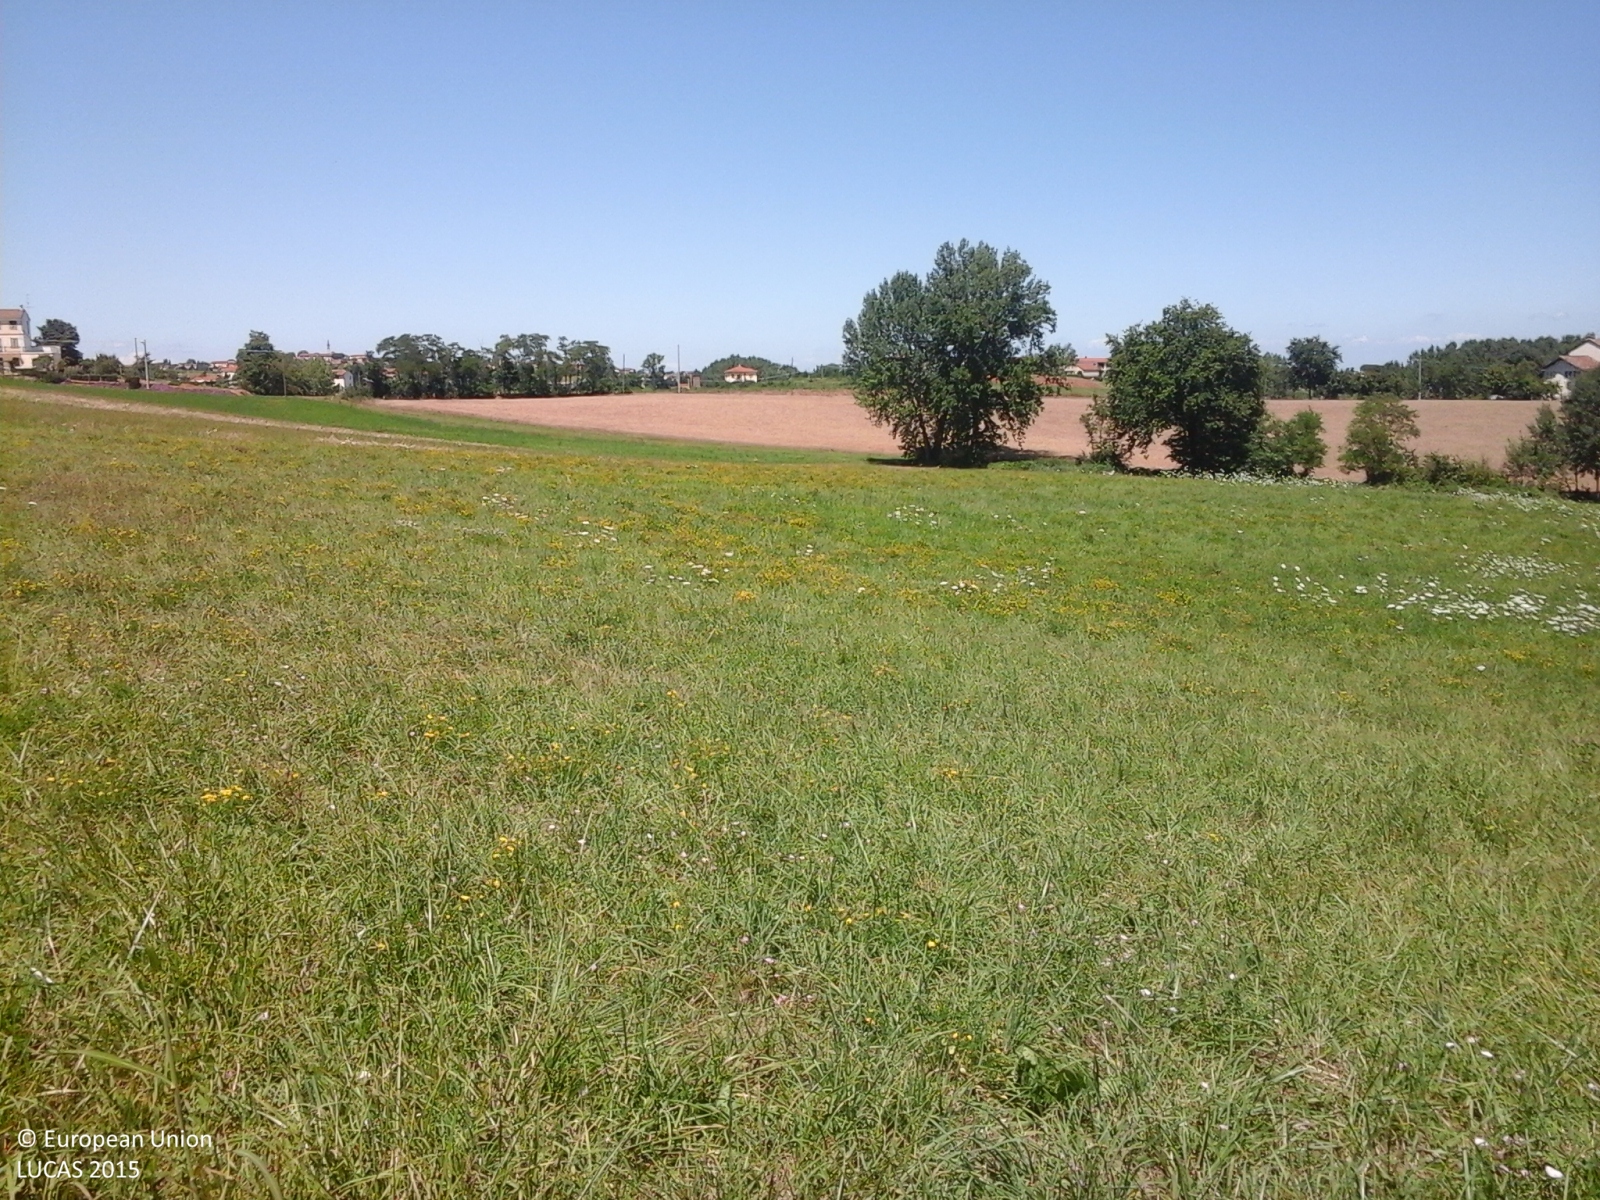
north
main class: Cropland
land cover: Common wheat
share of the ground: > 75 %
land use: Agriculture (excluding fallow land and kitchen gardens)
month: June
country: IT
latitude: 45.0602
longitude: 8.4409
